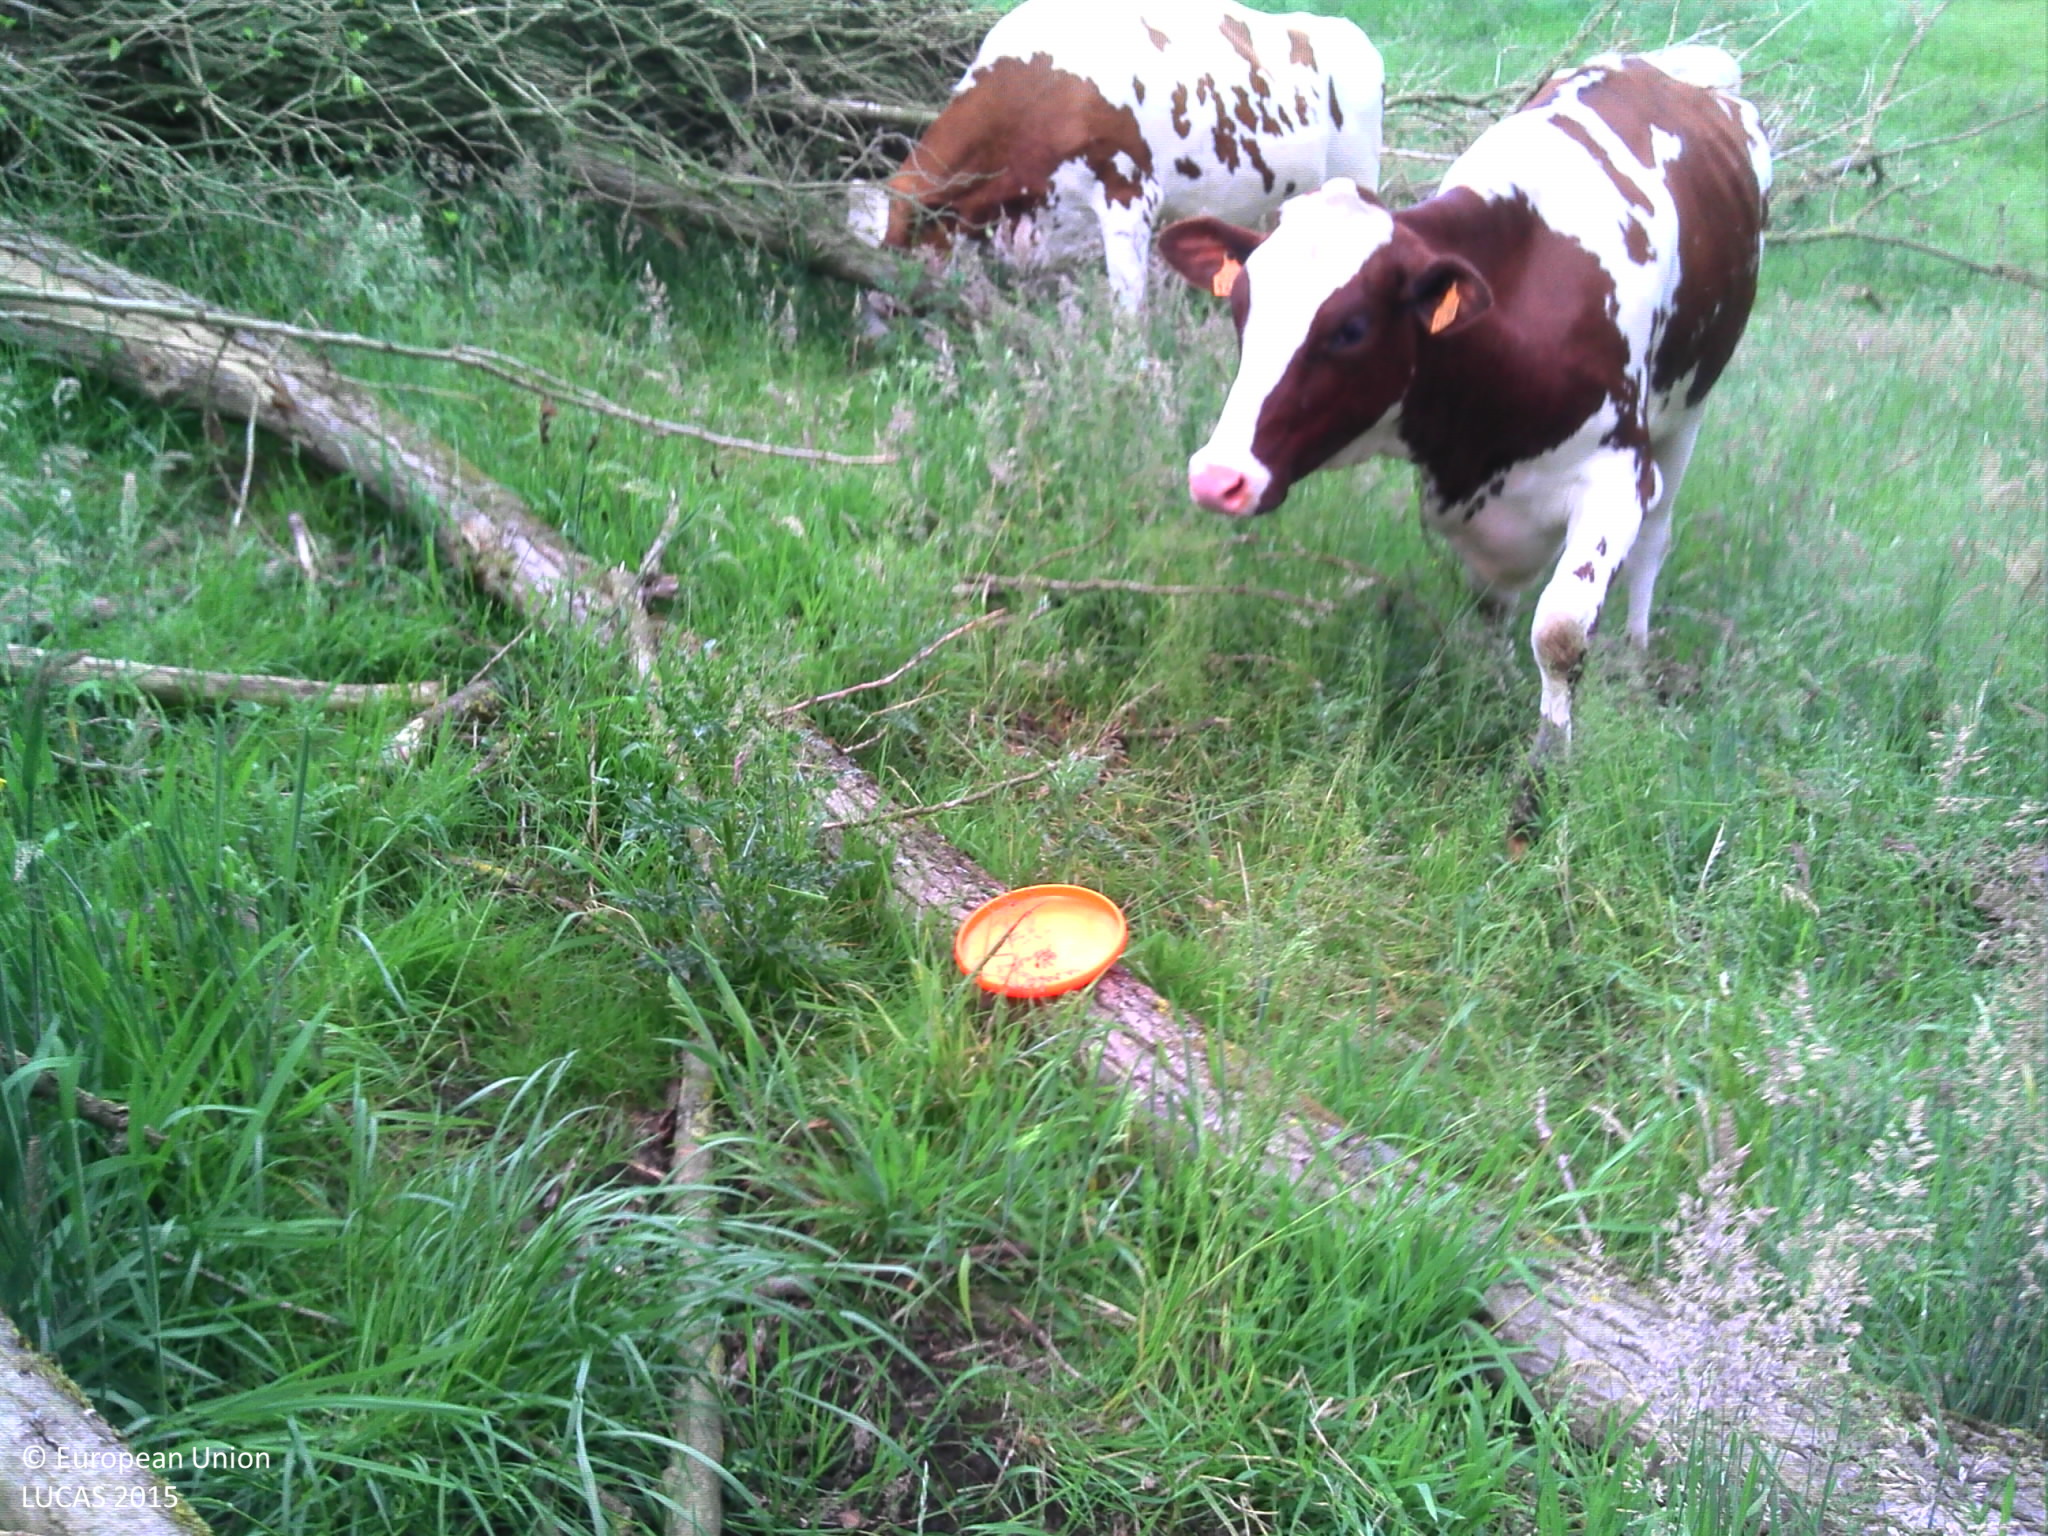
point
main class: Grassland
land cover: Grassland without tree/shrub cover
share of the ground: > 75 %
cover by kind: herbaceous plants 100 %
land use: Agriculture (excluding fallow land and kitchen gardens)
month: June
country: BE
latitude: 50.7788
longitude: 3.9097
